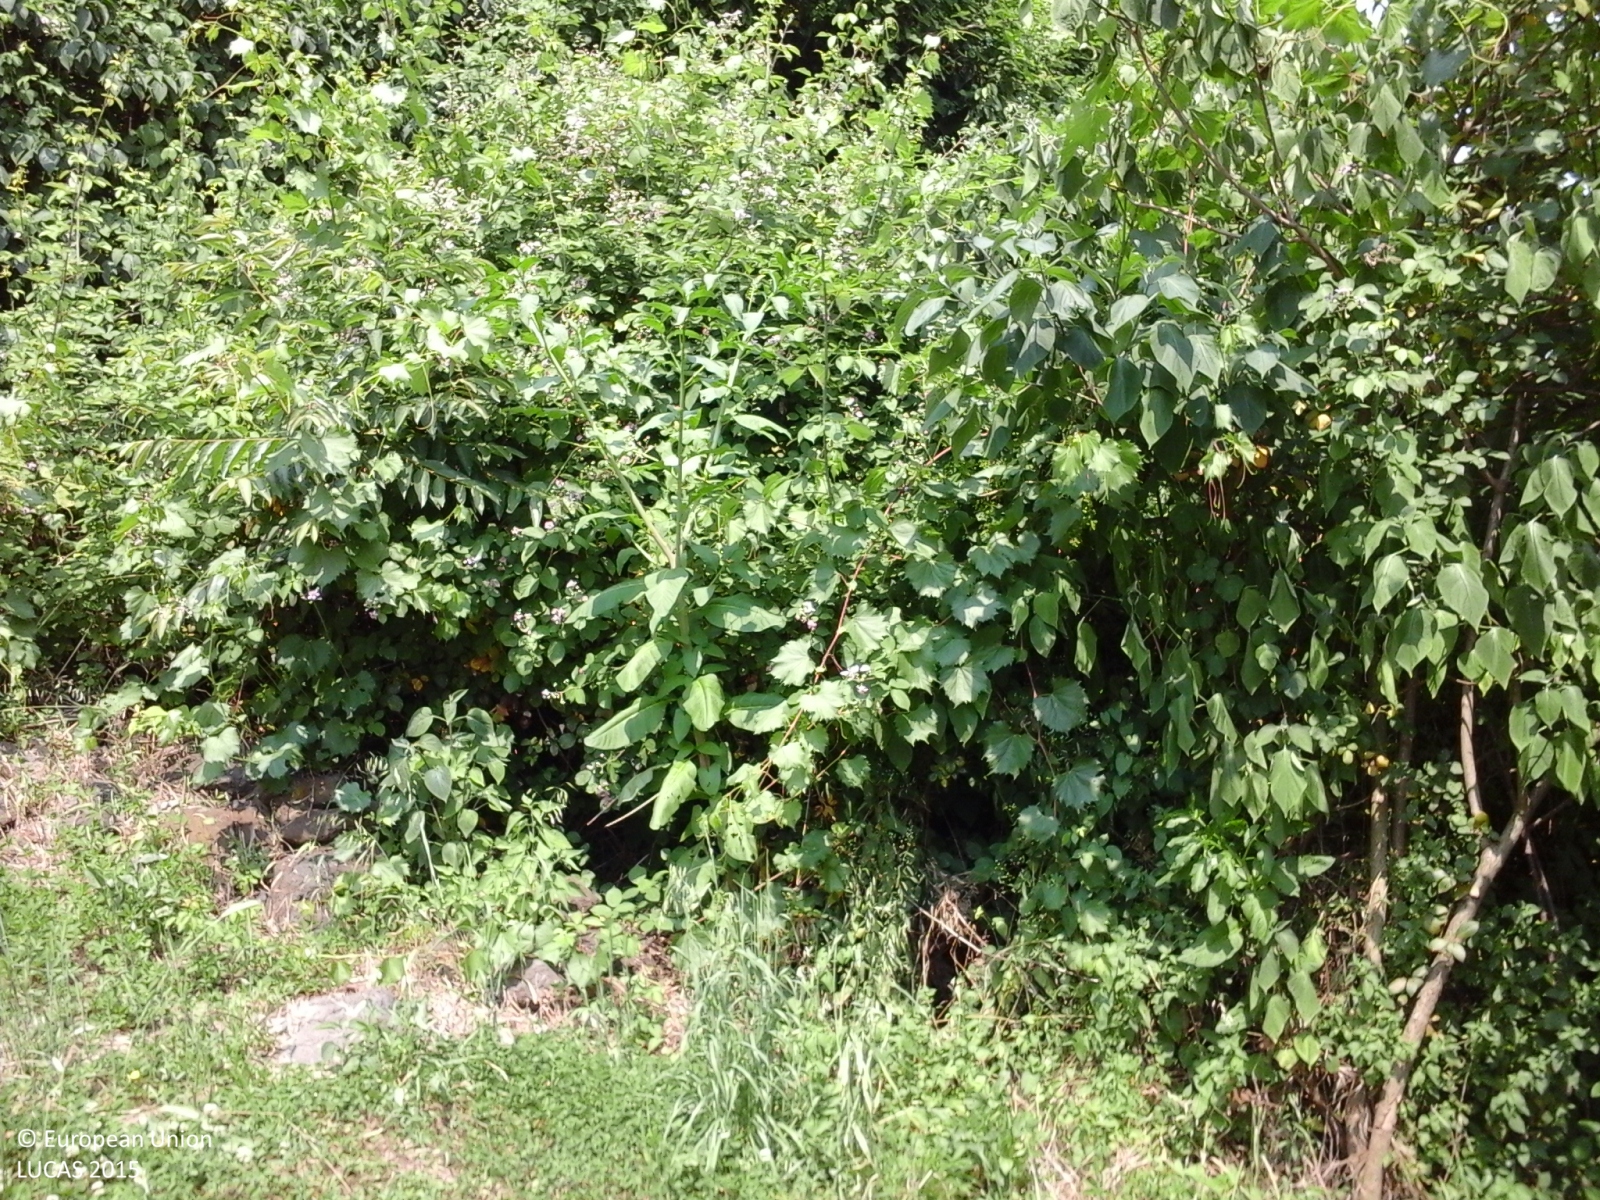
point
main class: Woodland
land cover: Broadleaved woodland
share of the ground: > 75 %
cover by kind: broadleaved forest trees 100 %
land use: Agriculture (excluding fallow land and kitchen gardens)
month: June
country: IT
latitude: 45.7445
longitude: 11.6042
